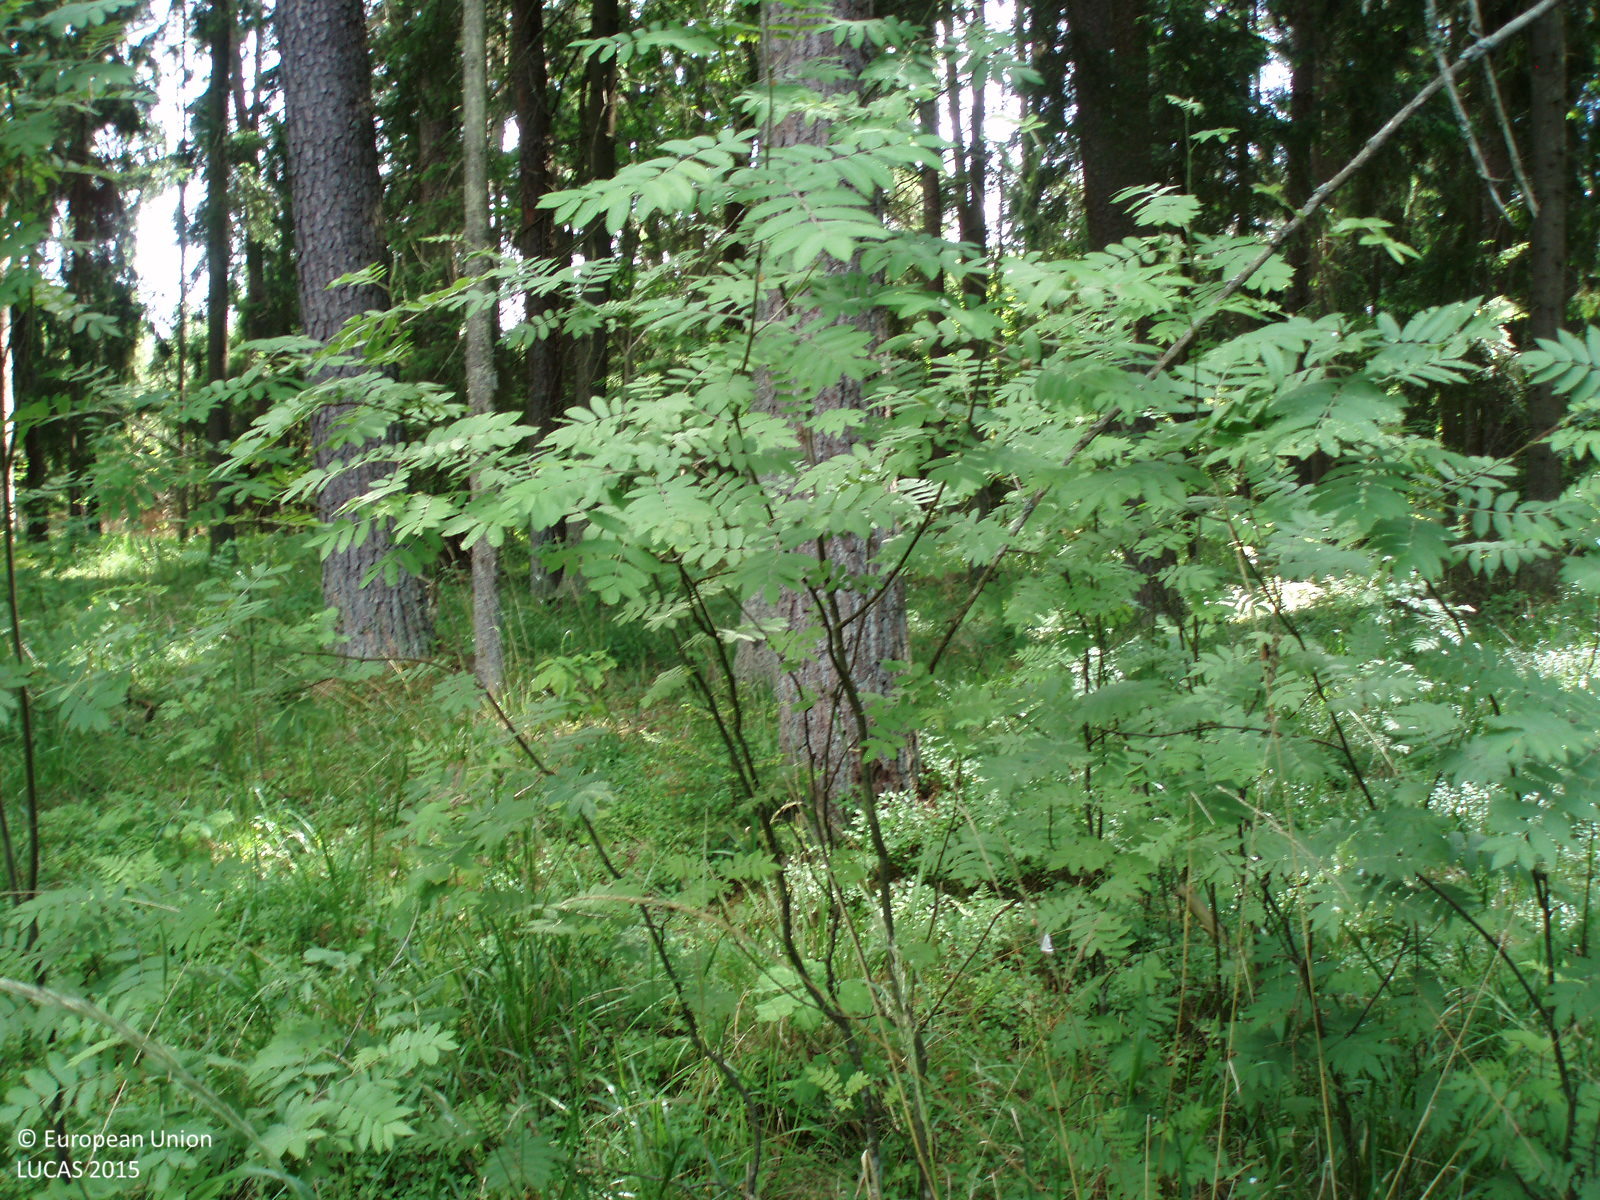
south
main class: Woodland
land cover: Other coniferous woodland
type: hemiboreal forest and nemoral coniferous forest and mixed broadleaved-coniferous forest
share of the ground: > 75 %
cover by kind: coniferous forest trees 70 %, herbaceous plants 20 %, broadleaved forest trees 10 %
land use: Forestry
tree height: > 5 m
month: June
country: LT
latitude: 55.0686
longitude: 22.4484
